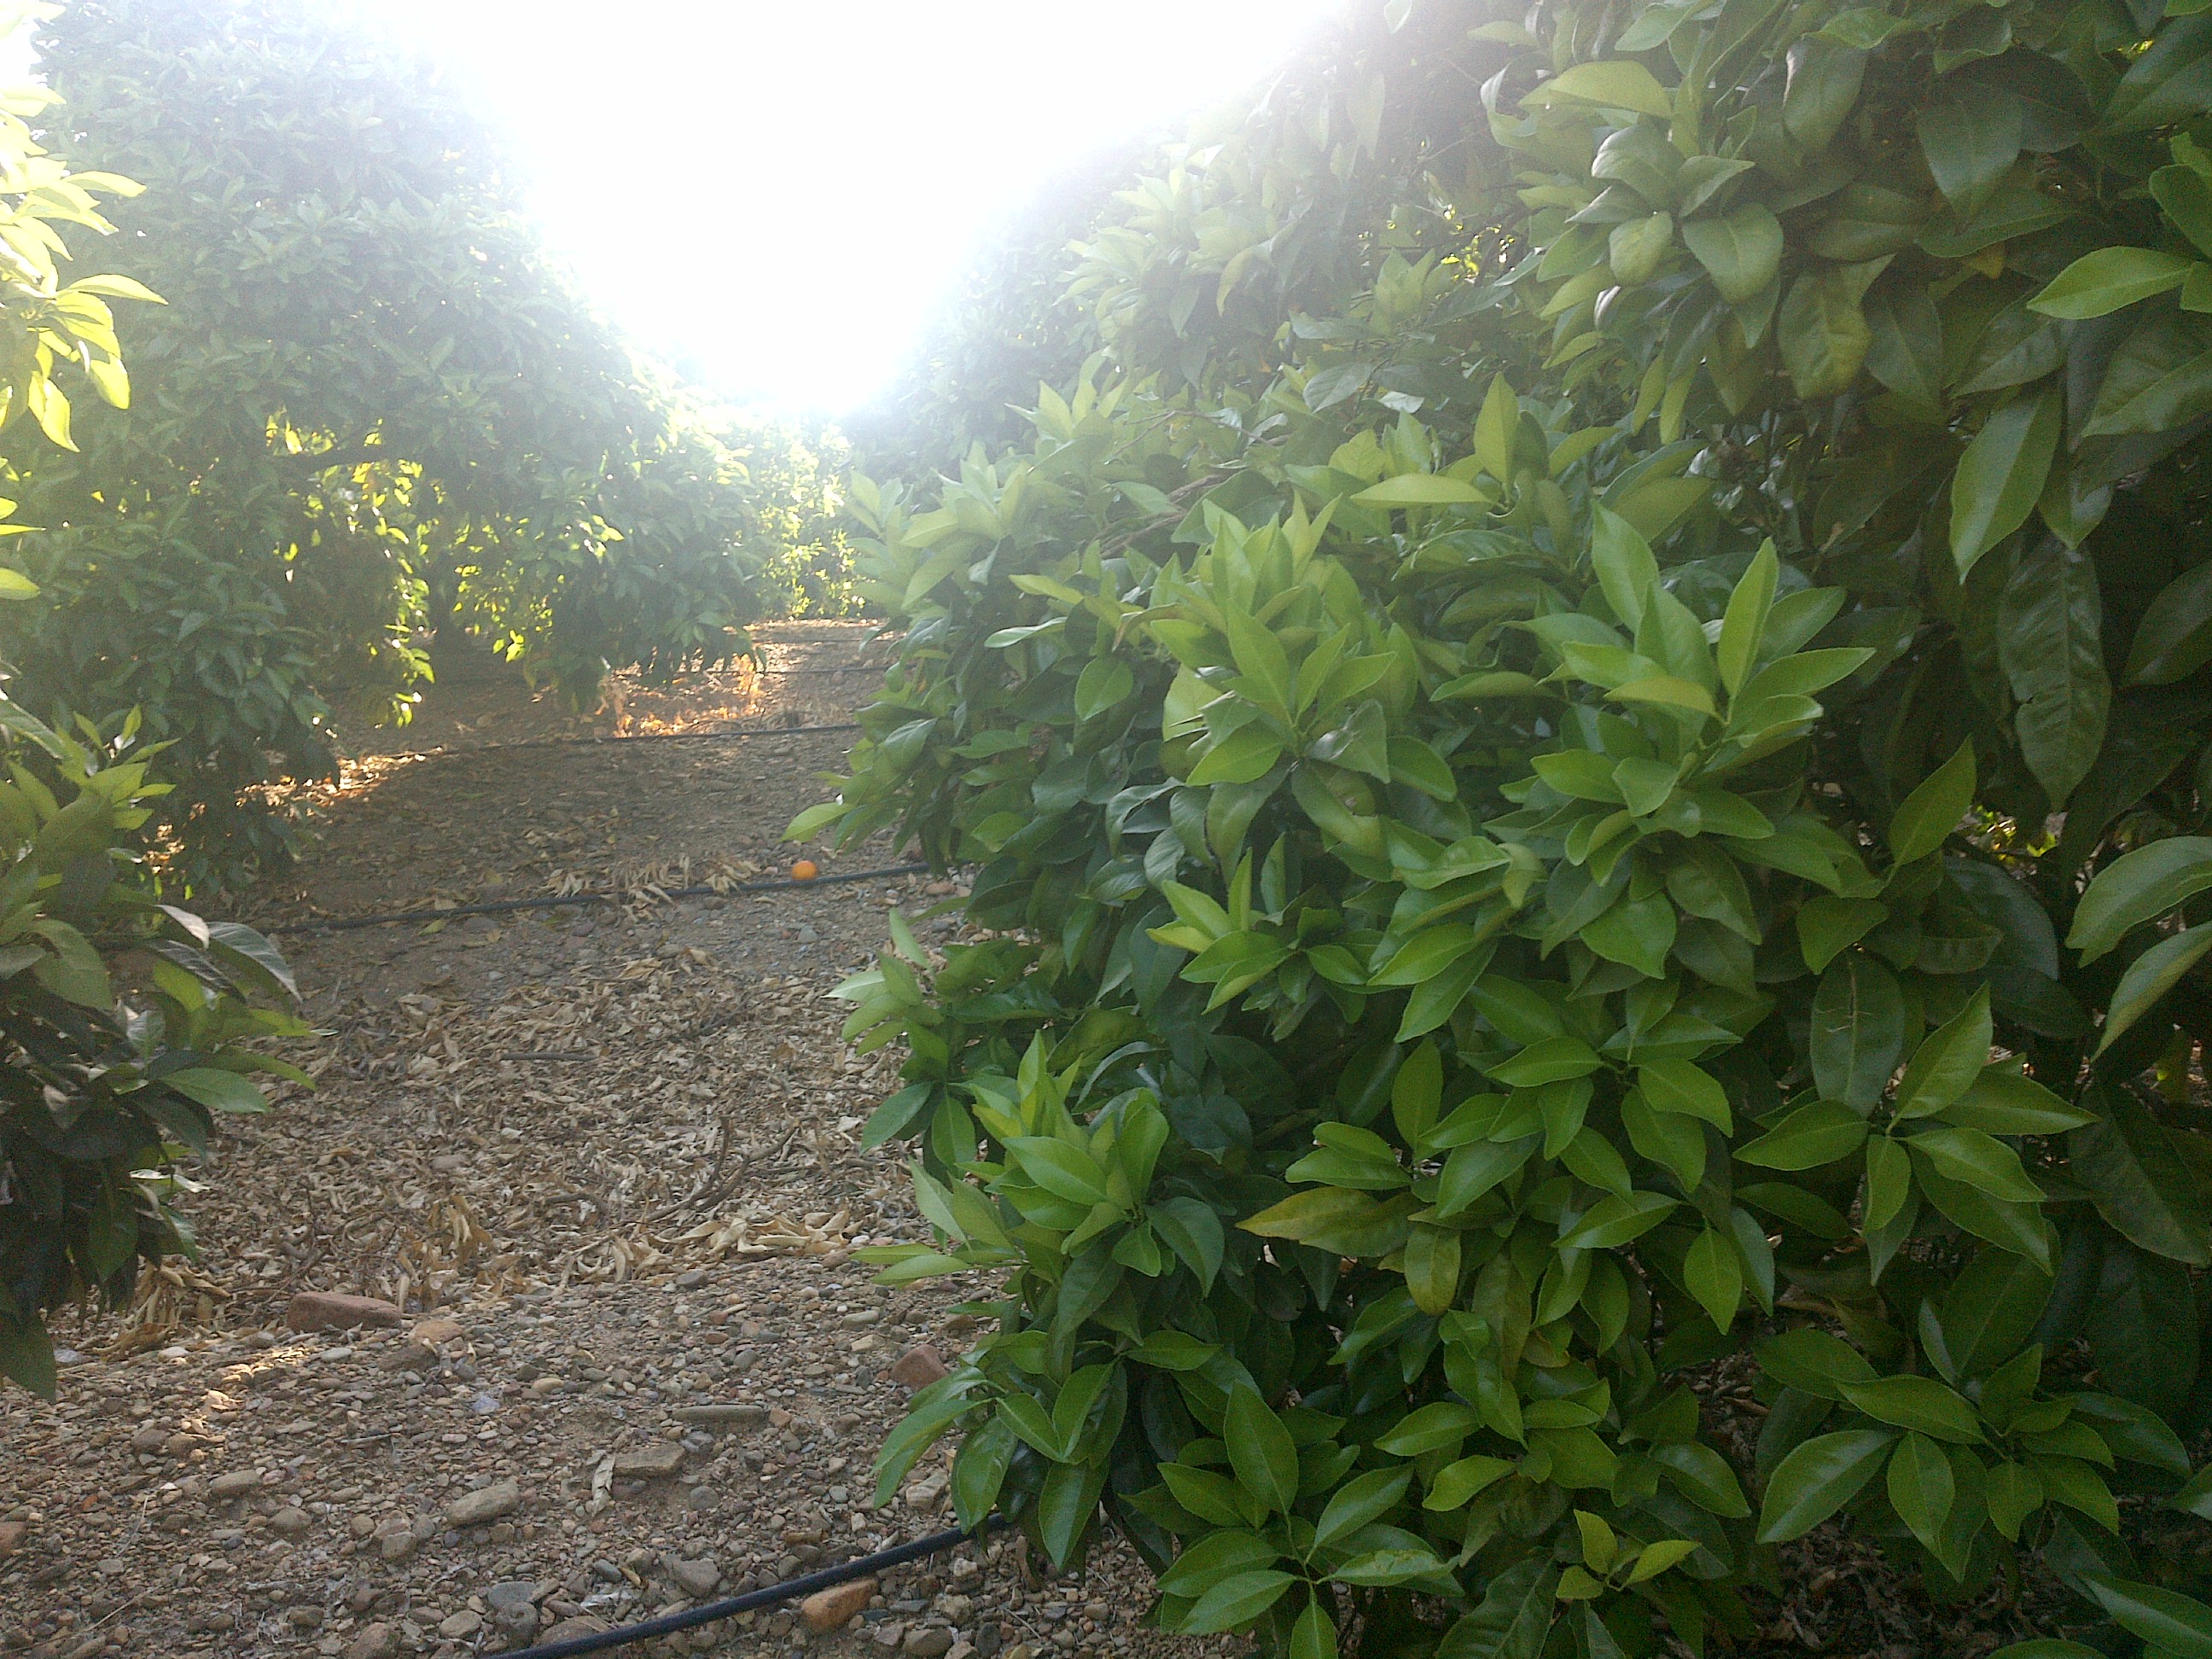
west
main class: Cropland
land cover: Oranges
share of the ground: > 75 %
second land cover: Other bare soil
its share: > 75 %
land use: Agriculture (excluding fallow land and kitchen gardens)
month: May
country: ES
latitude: 37.8021
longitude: -5.2270
